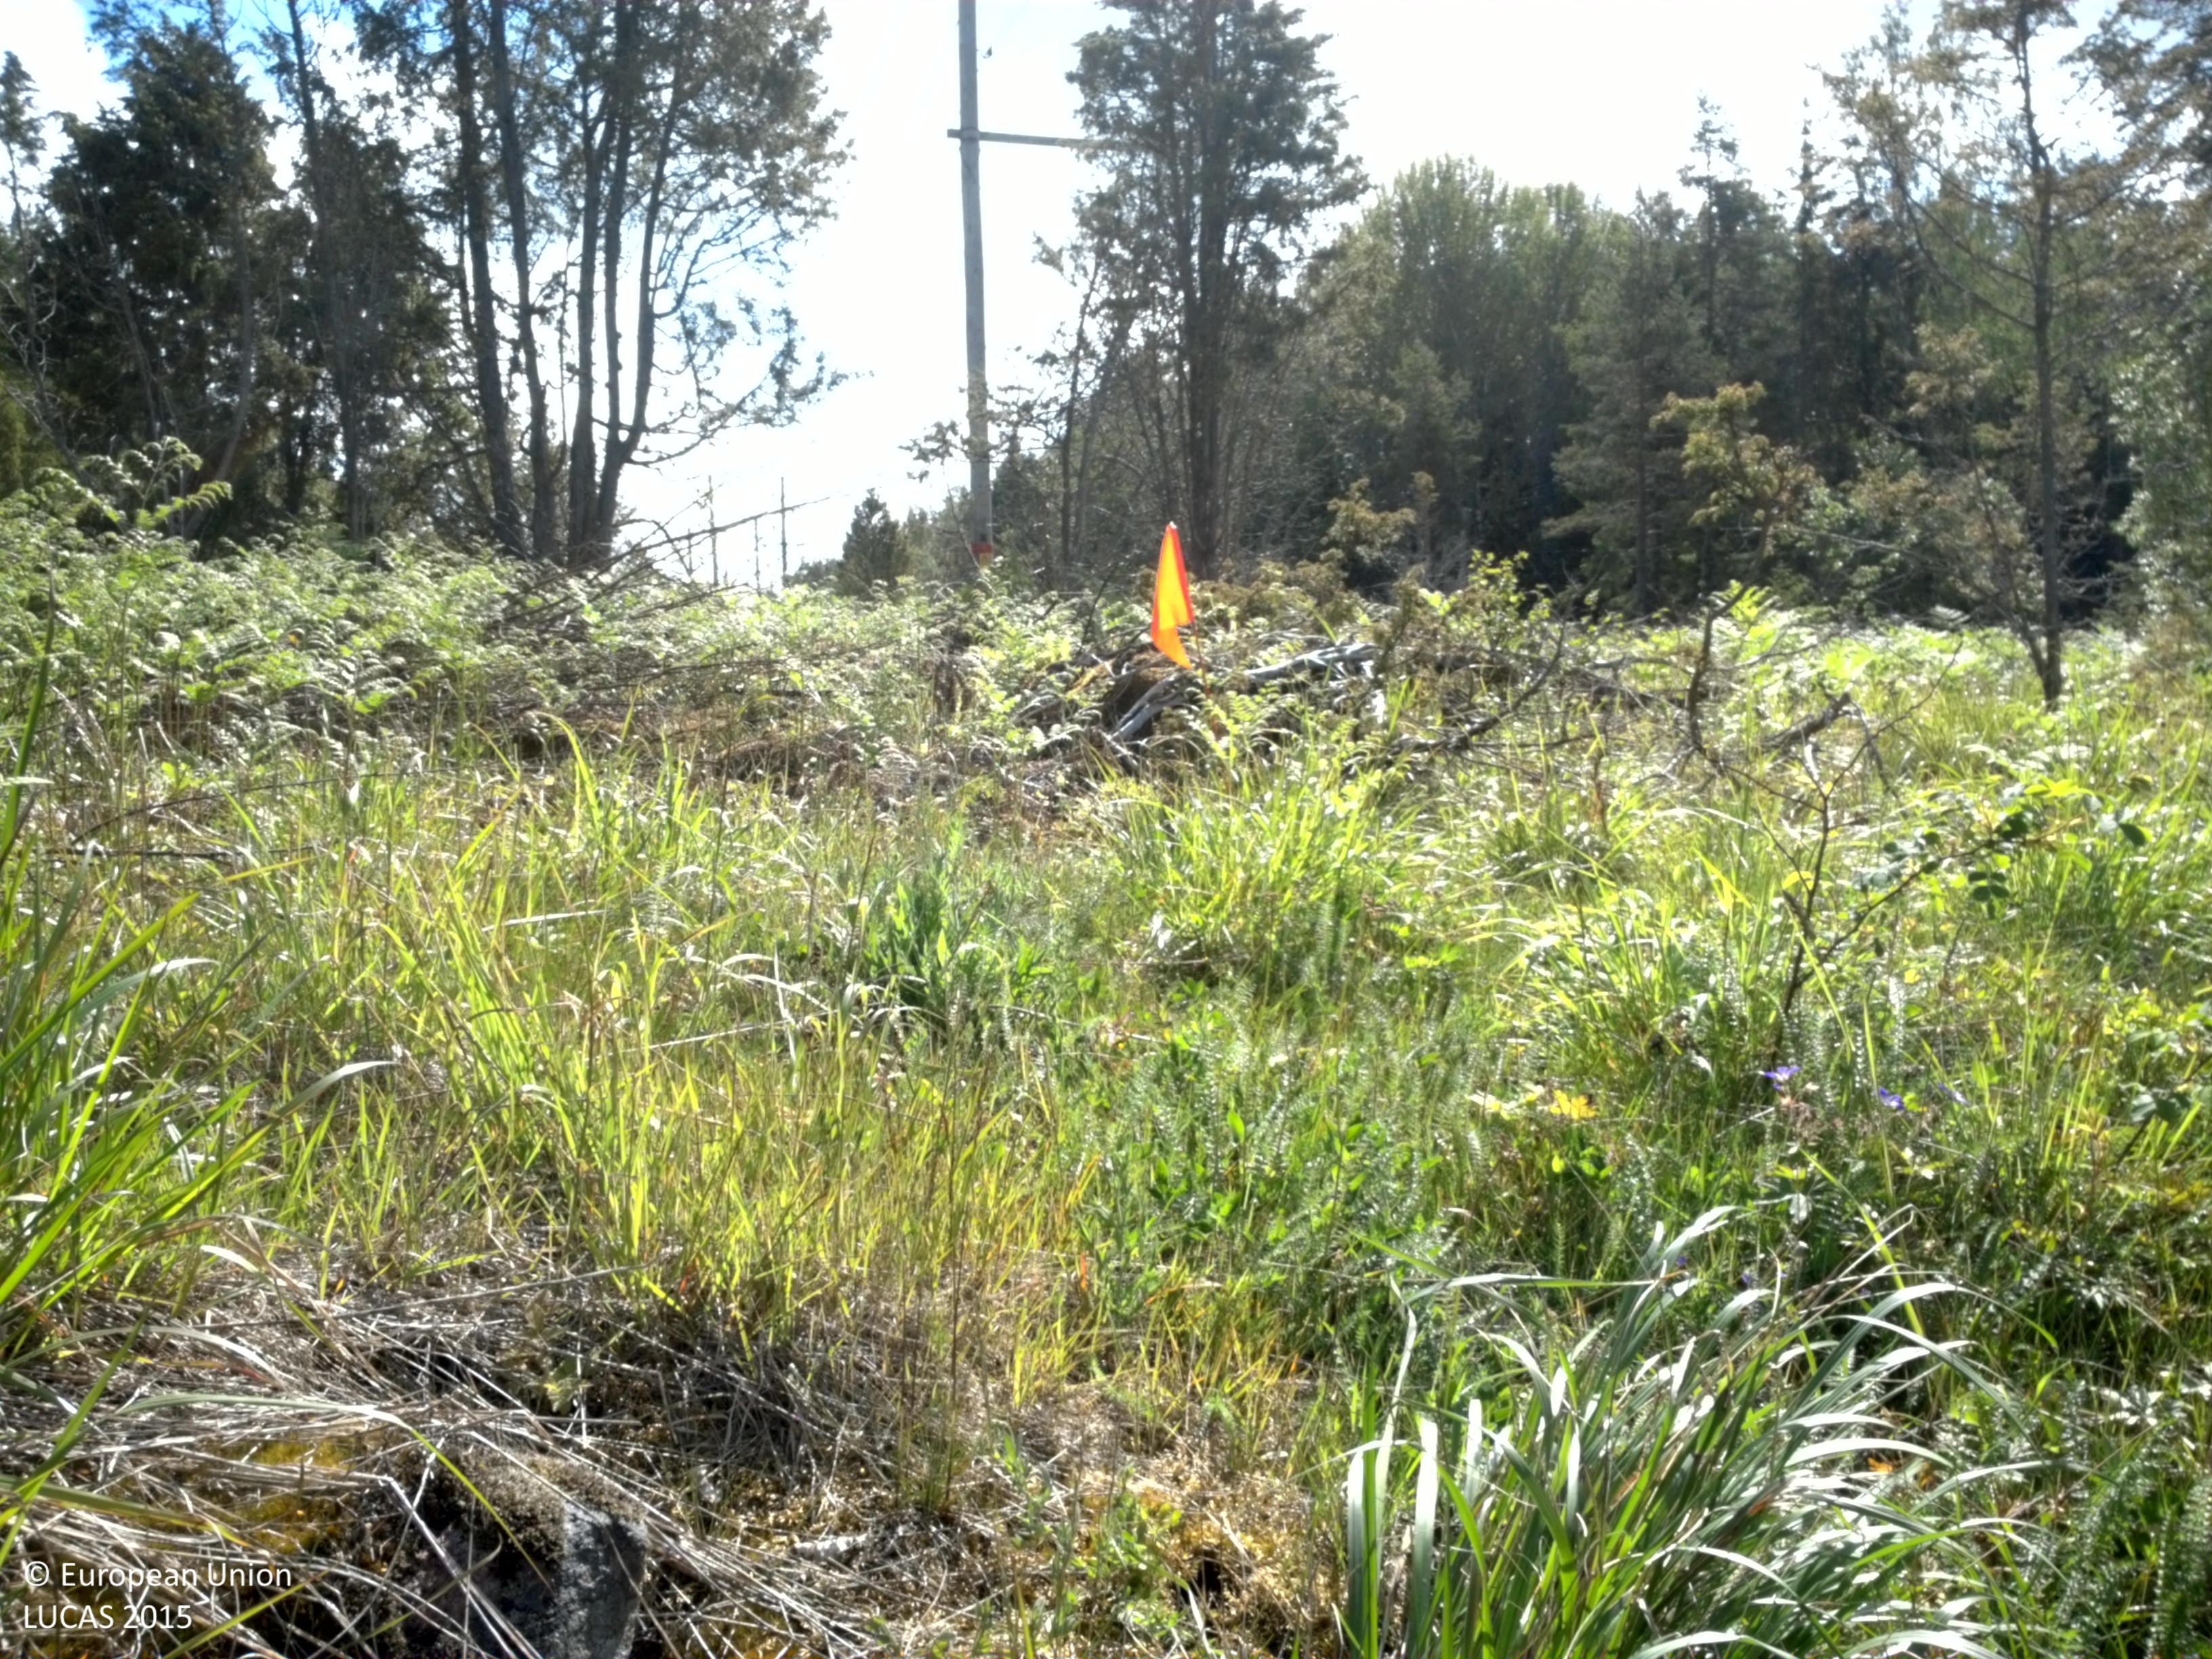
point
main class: Shrubland
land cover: Shrubland without tree cover
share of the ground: 10 - 25 %
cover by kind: herbaceous plants 65 %, shrubs 25 %, lichens and mosses 10 %
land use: Telecommunication
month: June
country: SE
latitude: 60.0560
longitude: 18.7094
